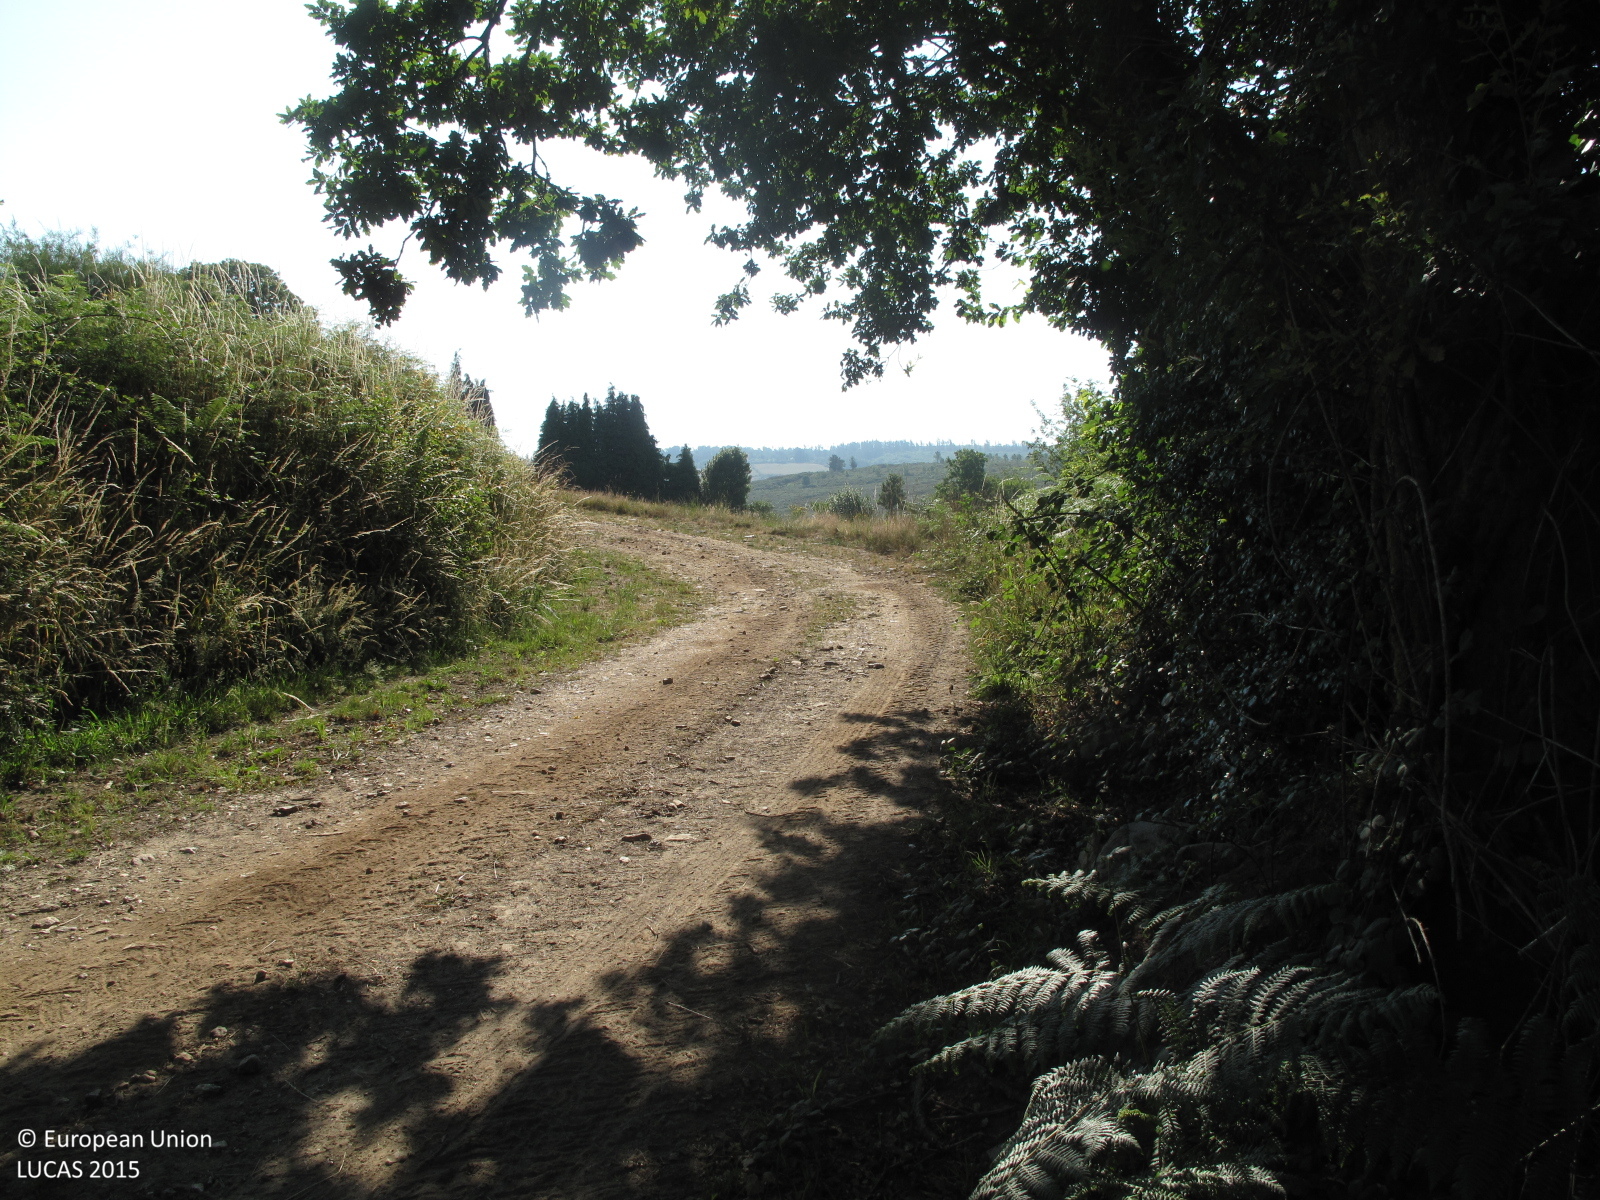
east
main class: Shrubland
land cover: Shrubland with sparse tree cover
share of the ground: > 75 %
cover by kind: shrubs 95 %, broadleaved forest trees 5 %
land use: Abandoned areas
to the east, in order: Shrubland with sparse tree cover; Broadleaved woodland; Grassland without tree/shrub cover; Tracks; Fences; Abandoned hedges; Grassland without tree/shrub cover; Broadleaved woodland; Fences; Tracks; Electric lines; Broadleaved woodland; Abandoned hedges; Grassland without tree/shrub cover
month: July
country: ES
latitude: 43.3252
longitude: -7.9364
